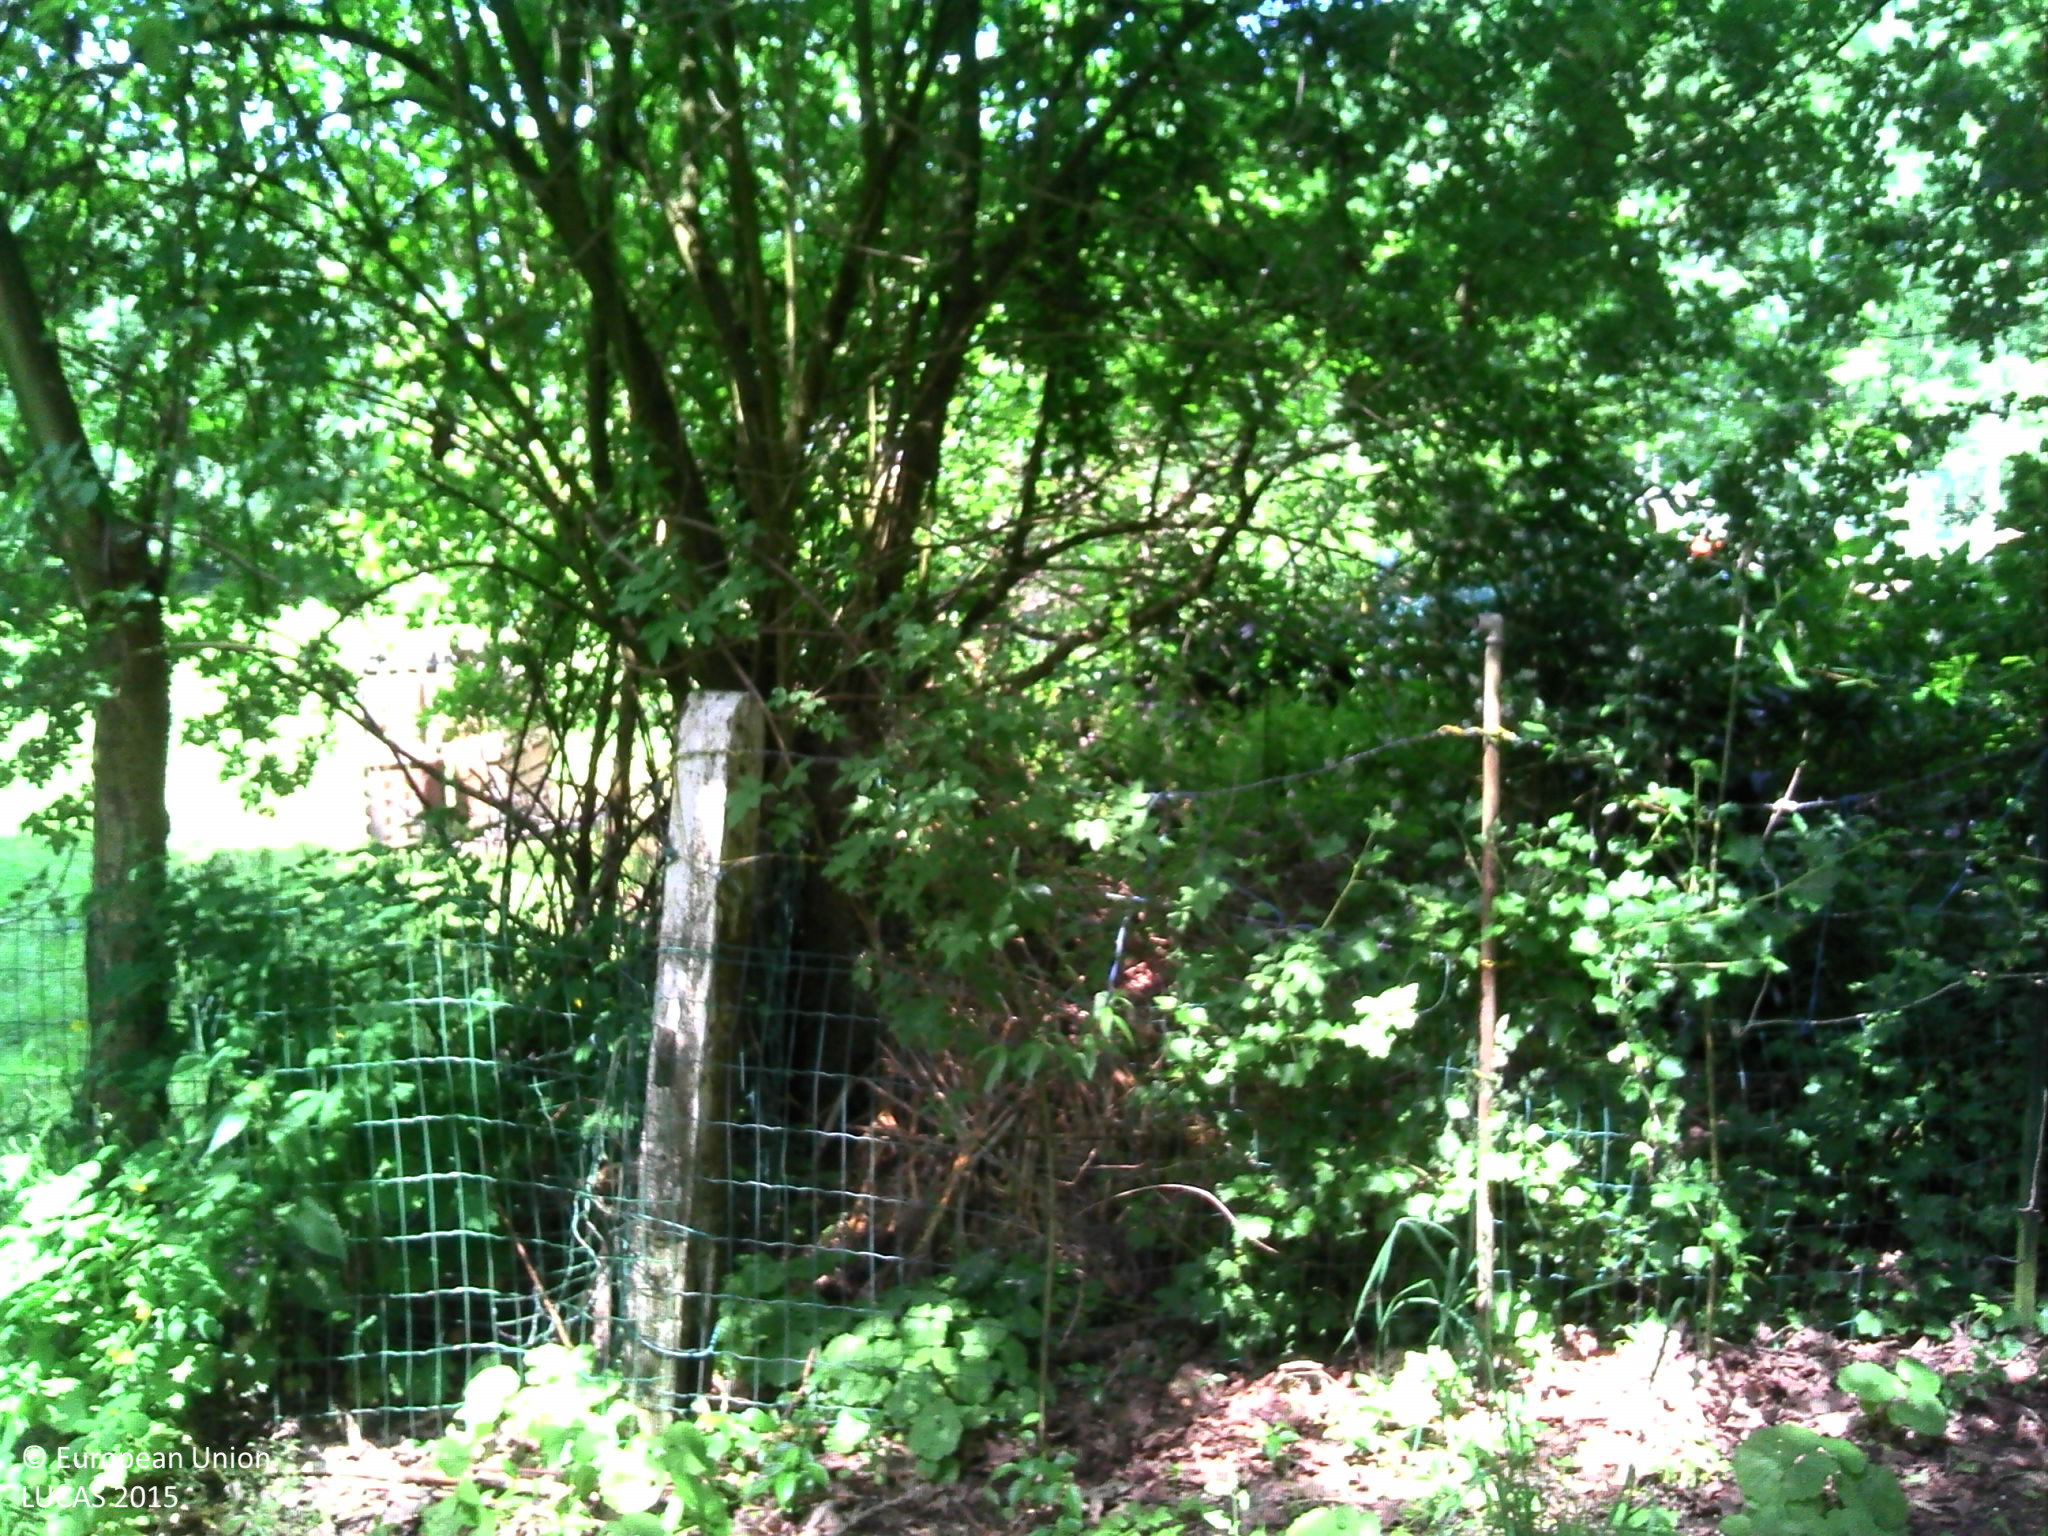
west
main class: Woodland
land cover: Broadleaved woodland
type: mesophytic deciduous forest
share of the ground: > 75 %
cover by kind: broadleaved forest trees 100 %
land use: Forestry
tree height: > 5 m
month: June
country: BE
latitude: 51.0175
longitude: 3.9927
